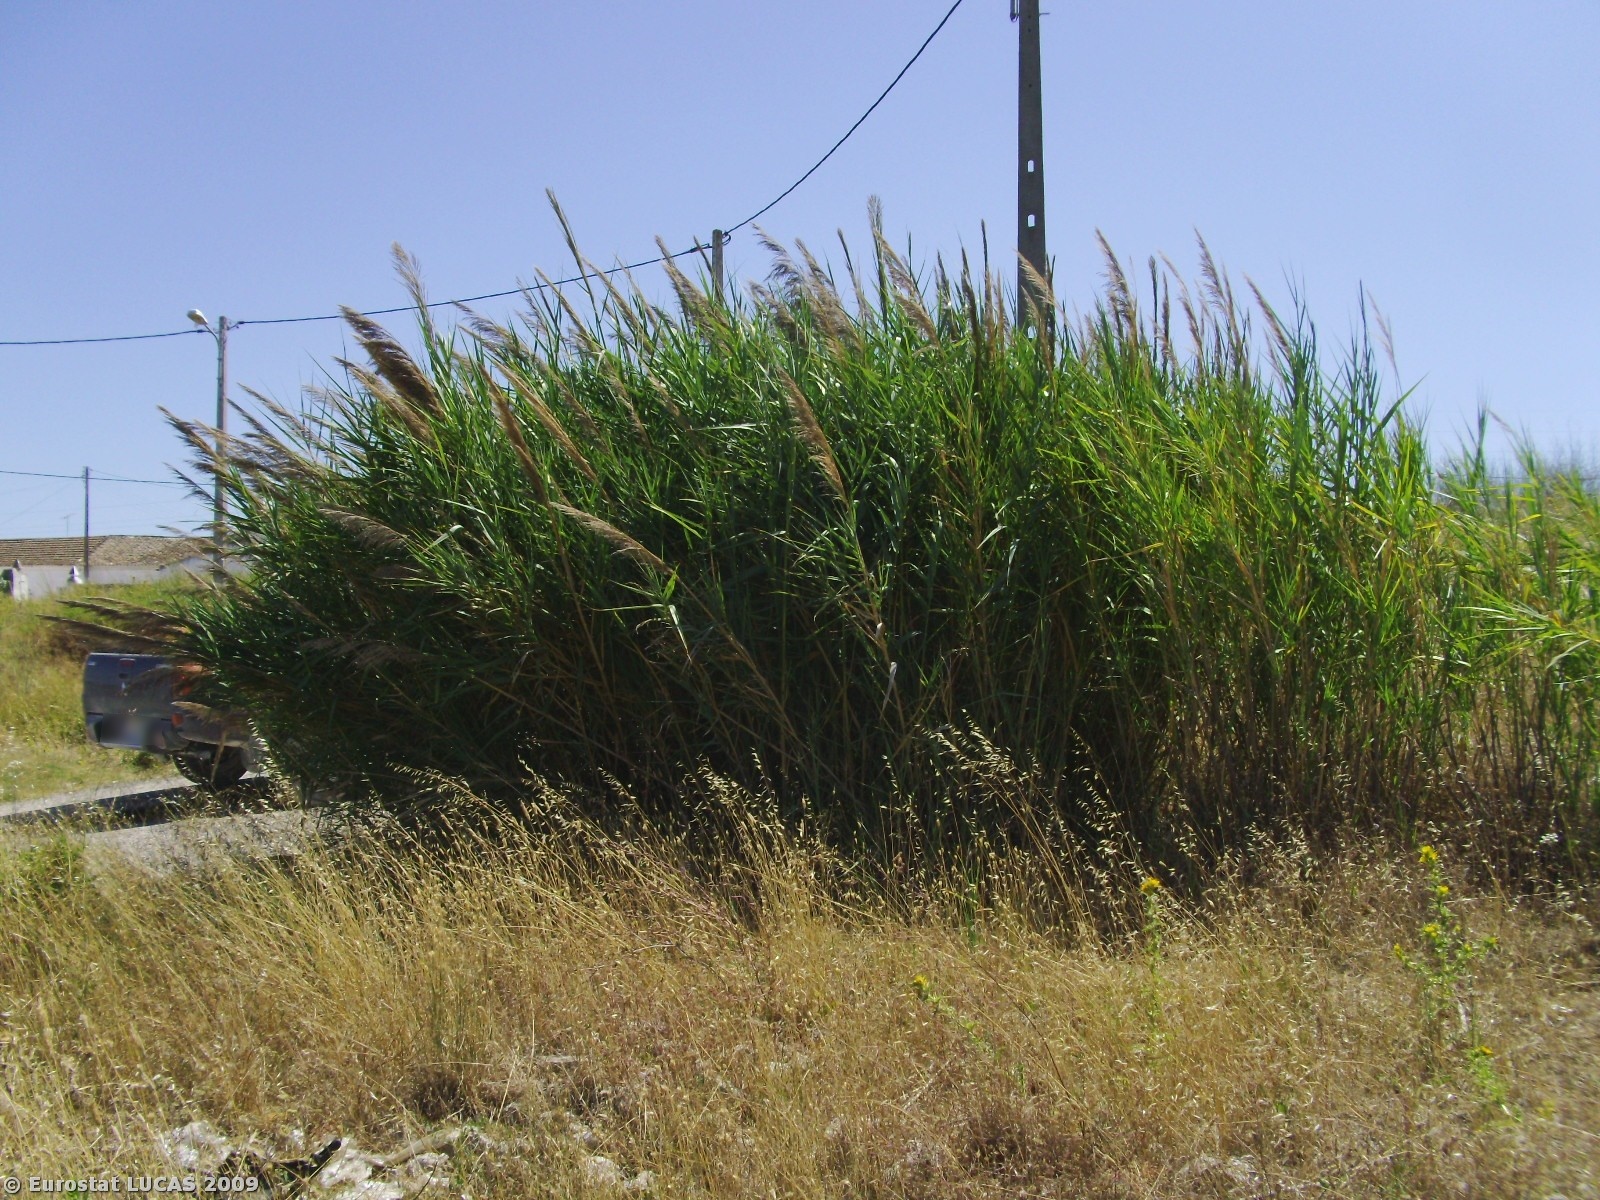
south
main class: Grassland
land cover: Spontaneously vegetated surfaces
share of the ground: > 75 %
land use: Unused
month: July
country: PT
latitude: 39.0461
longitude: -8.9679
